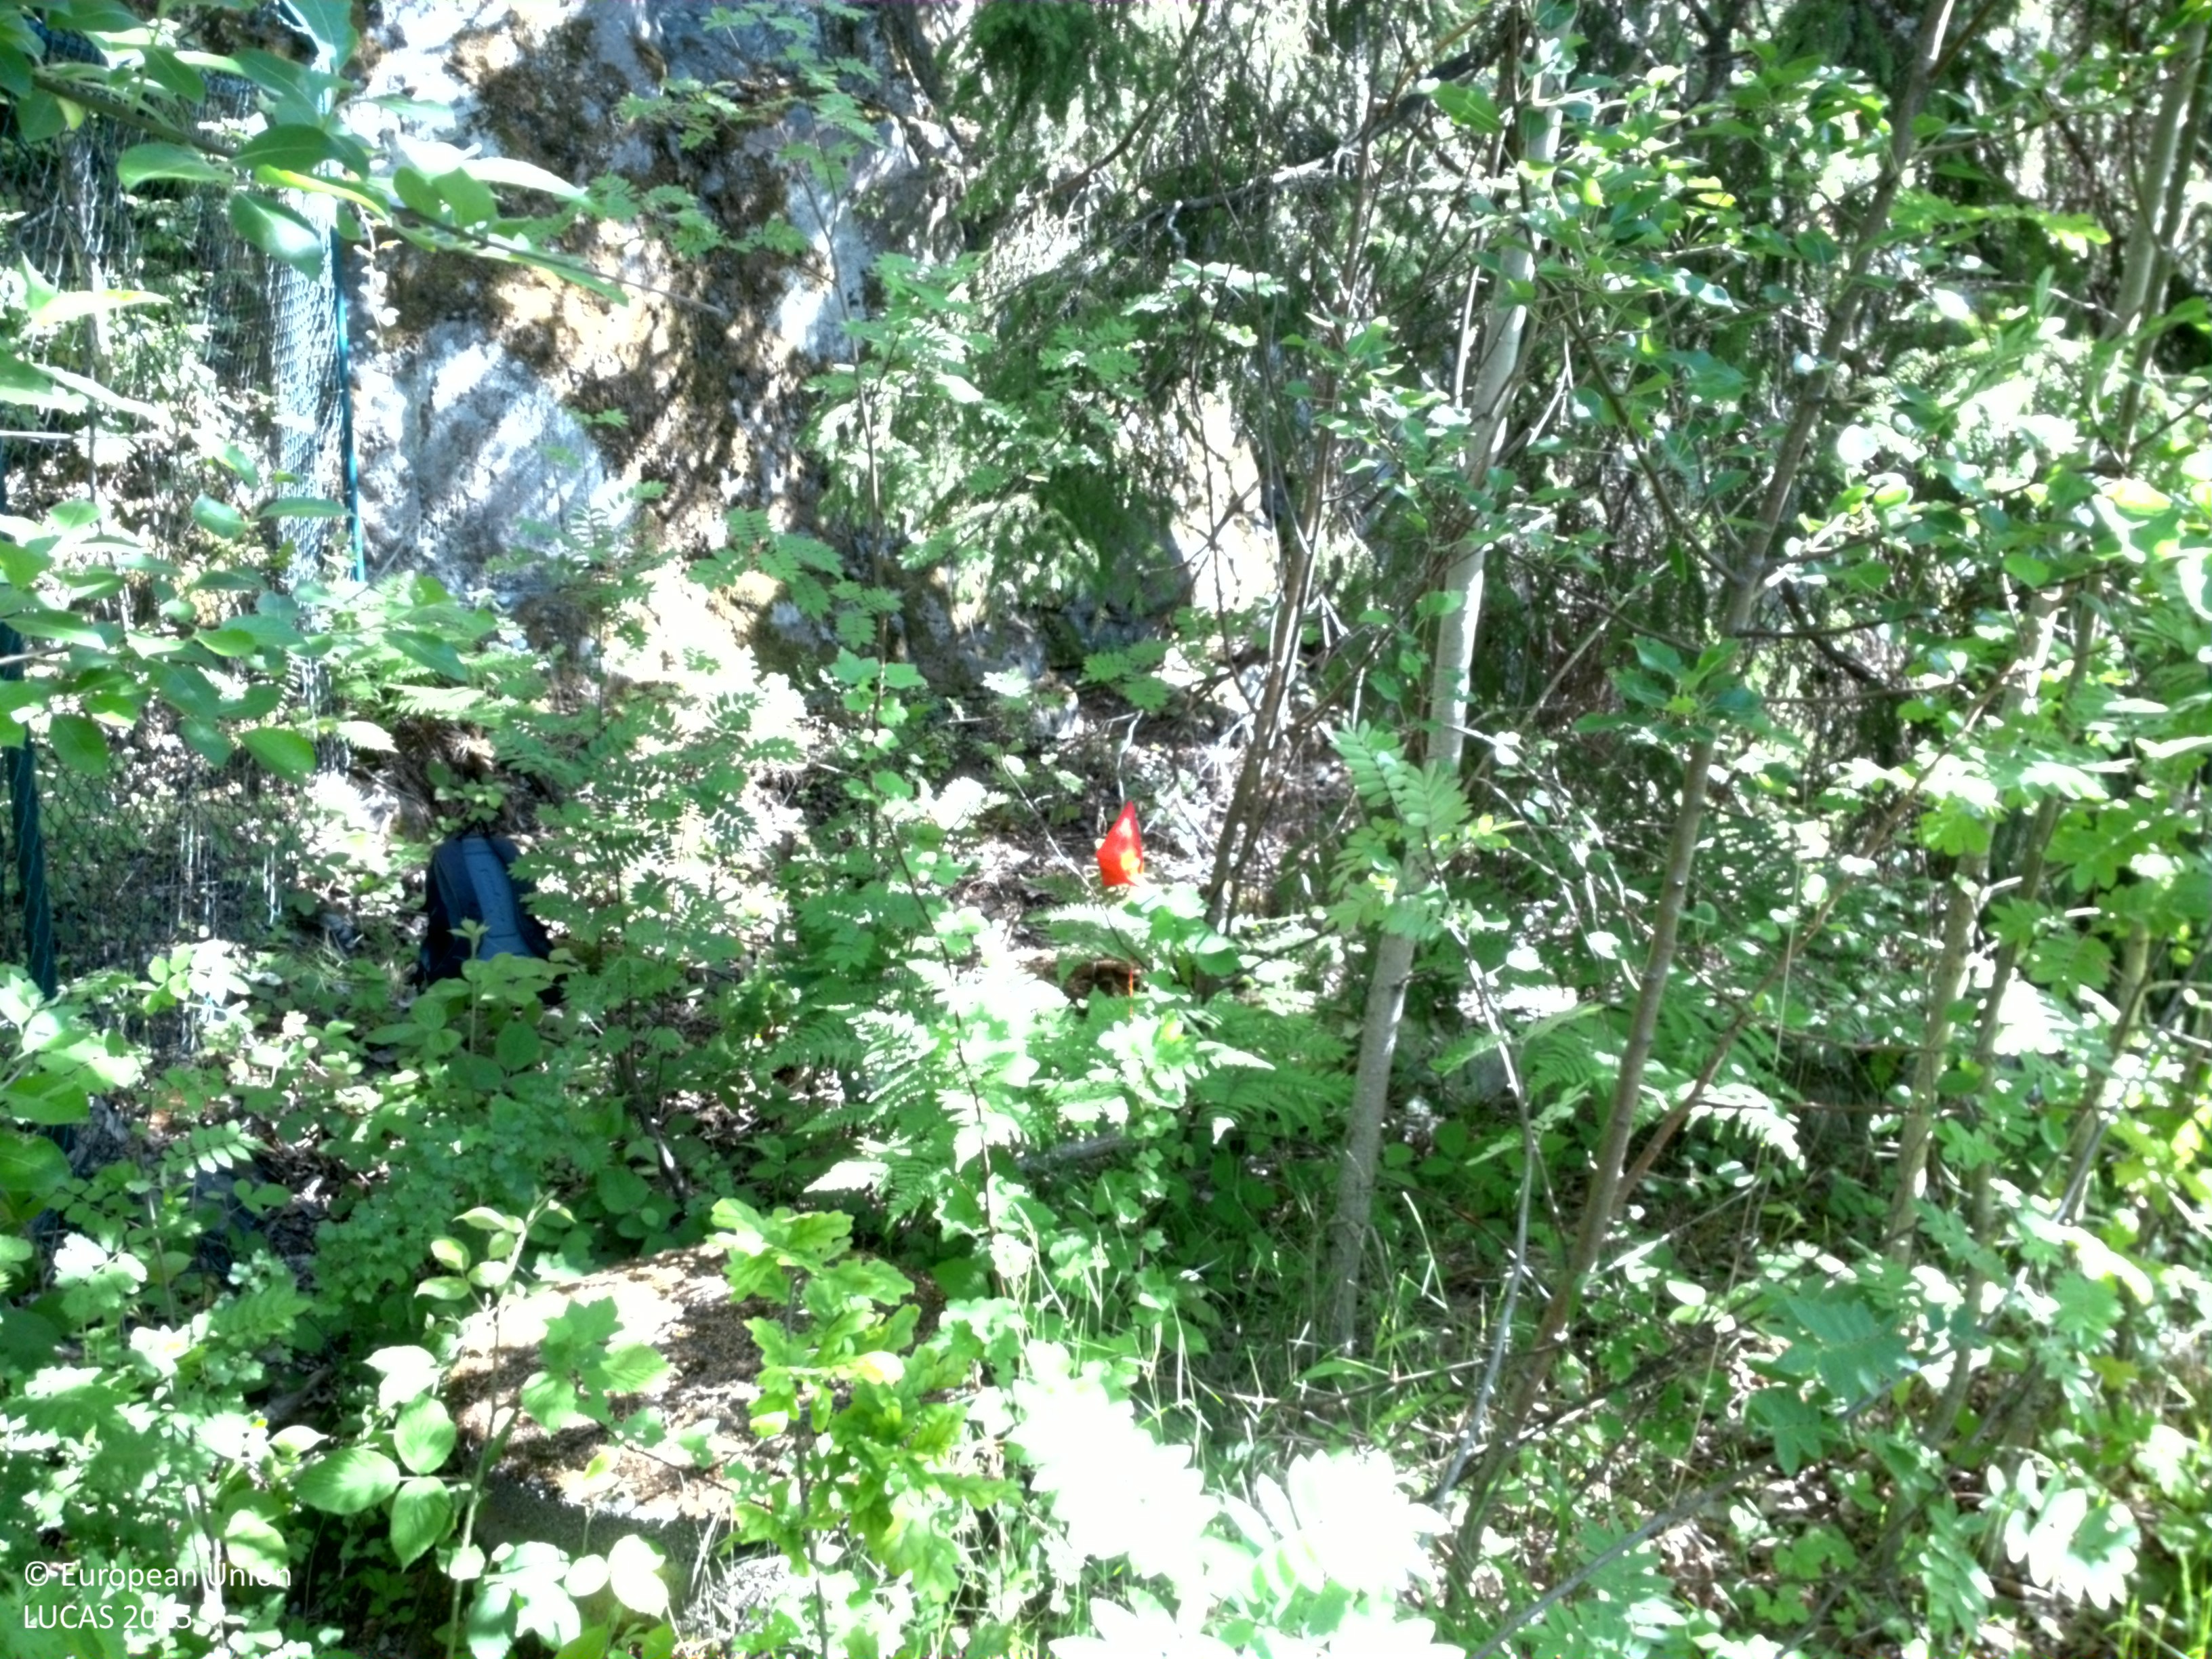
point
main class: Woodland
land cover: Spruce dominated mixed woodland
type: boreal forest
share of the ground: 50 - 75 %
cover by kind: coniferous forest trees 45 %, broadleaved forest trees 30 %, herbaceous plants 20 %, lichens and mosses 5 %
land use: Semi-natural and natural areas not in use
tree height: > 5 m
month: June
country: SE
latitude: 58.6600
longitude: 16.4596
